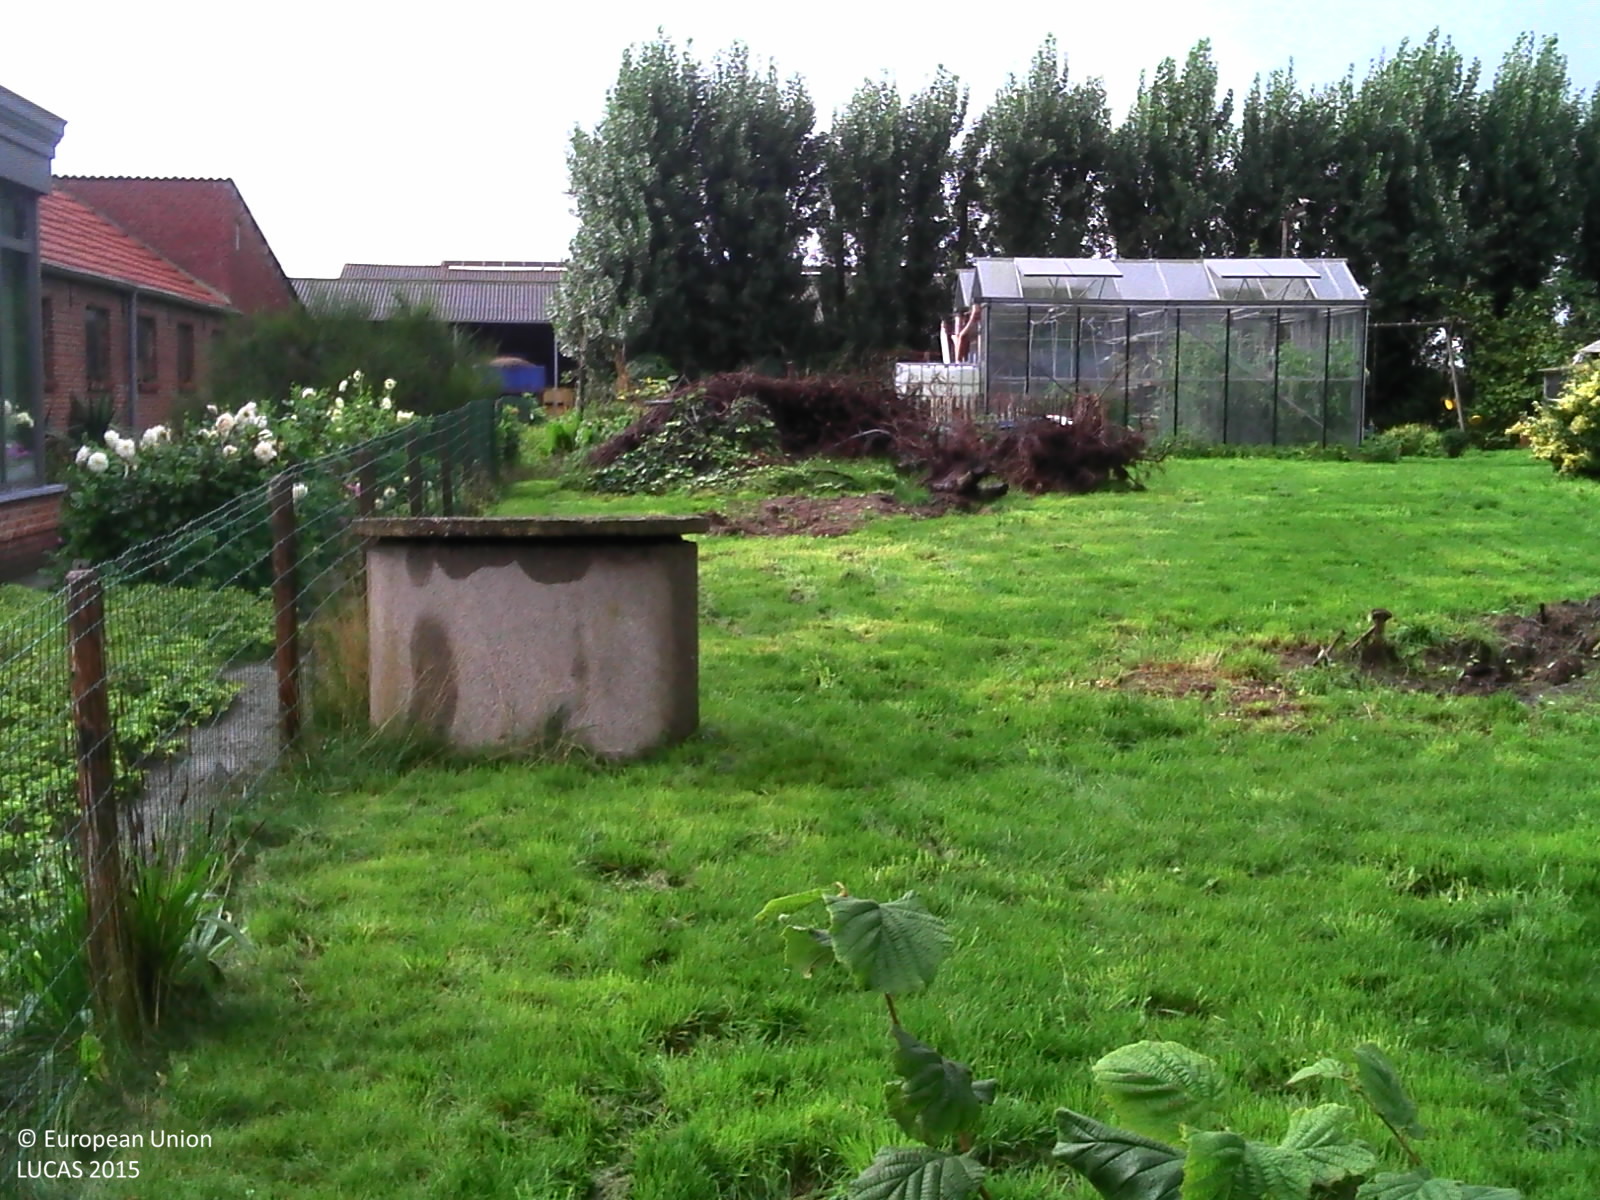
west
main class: Grassland
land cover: Grassland without tree/shrub cover
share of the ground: 25 - 50 %
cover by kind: unconsolidated bare surface 60 %, herbaceous plants 40 %
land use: Residential
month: September
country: BE
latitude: 51.3250
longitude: 4.7586
